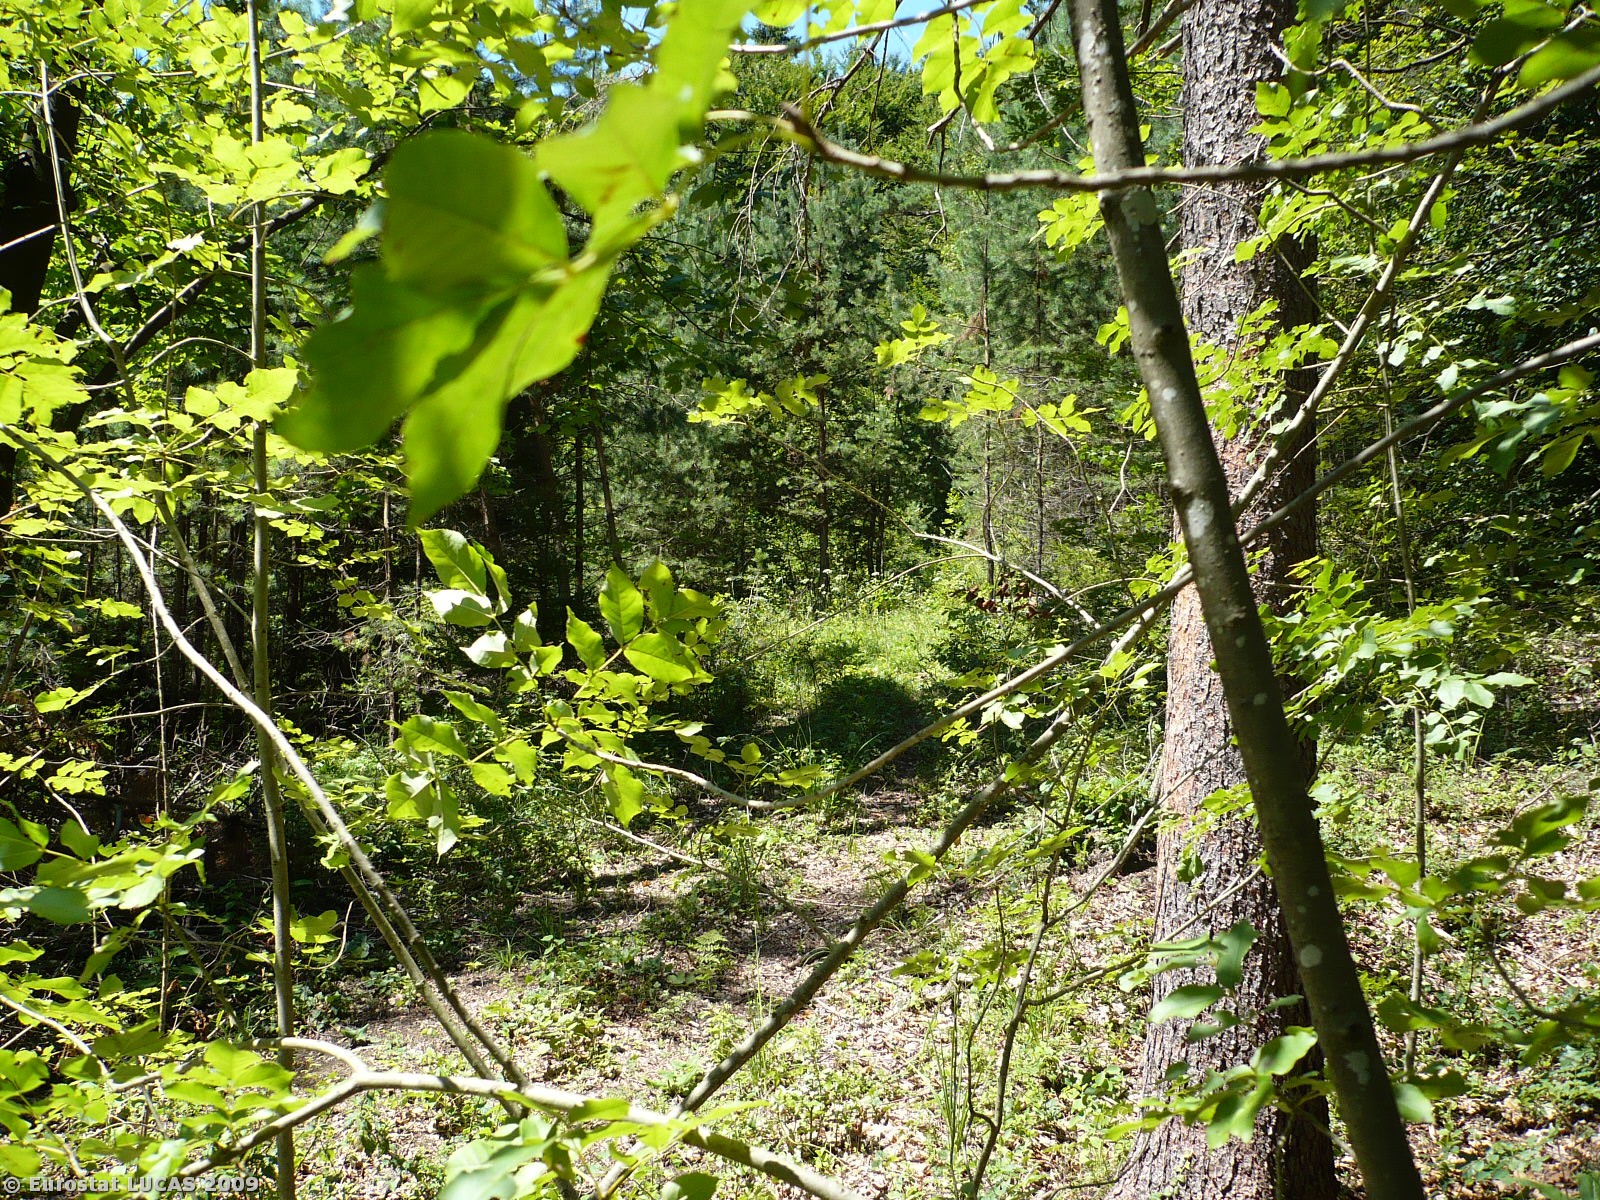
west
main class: Woodland
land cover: Mixed woodland
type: beech forest
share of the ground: 25 - 50 %
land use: Forestry
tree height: > 5 m
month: July
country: SI
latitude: 46.0043
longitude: 15.2788
